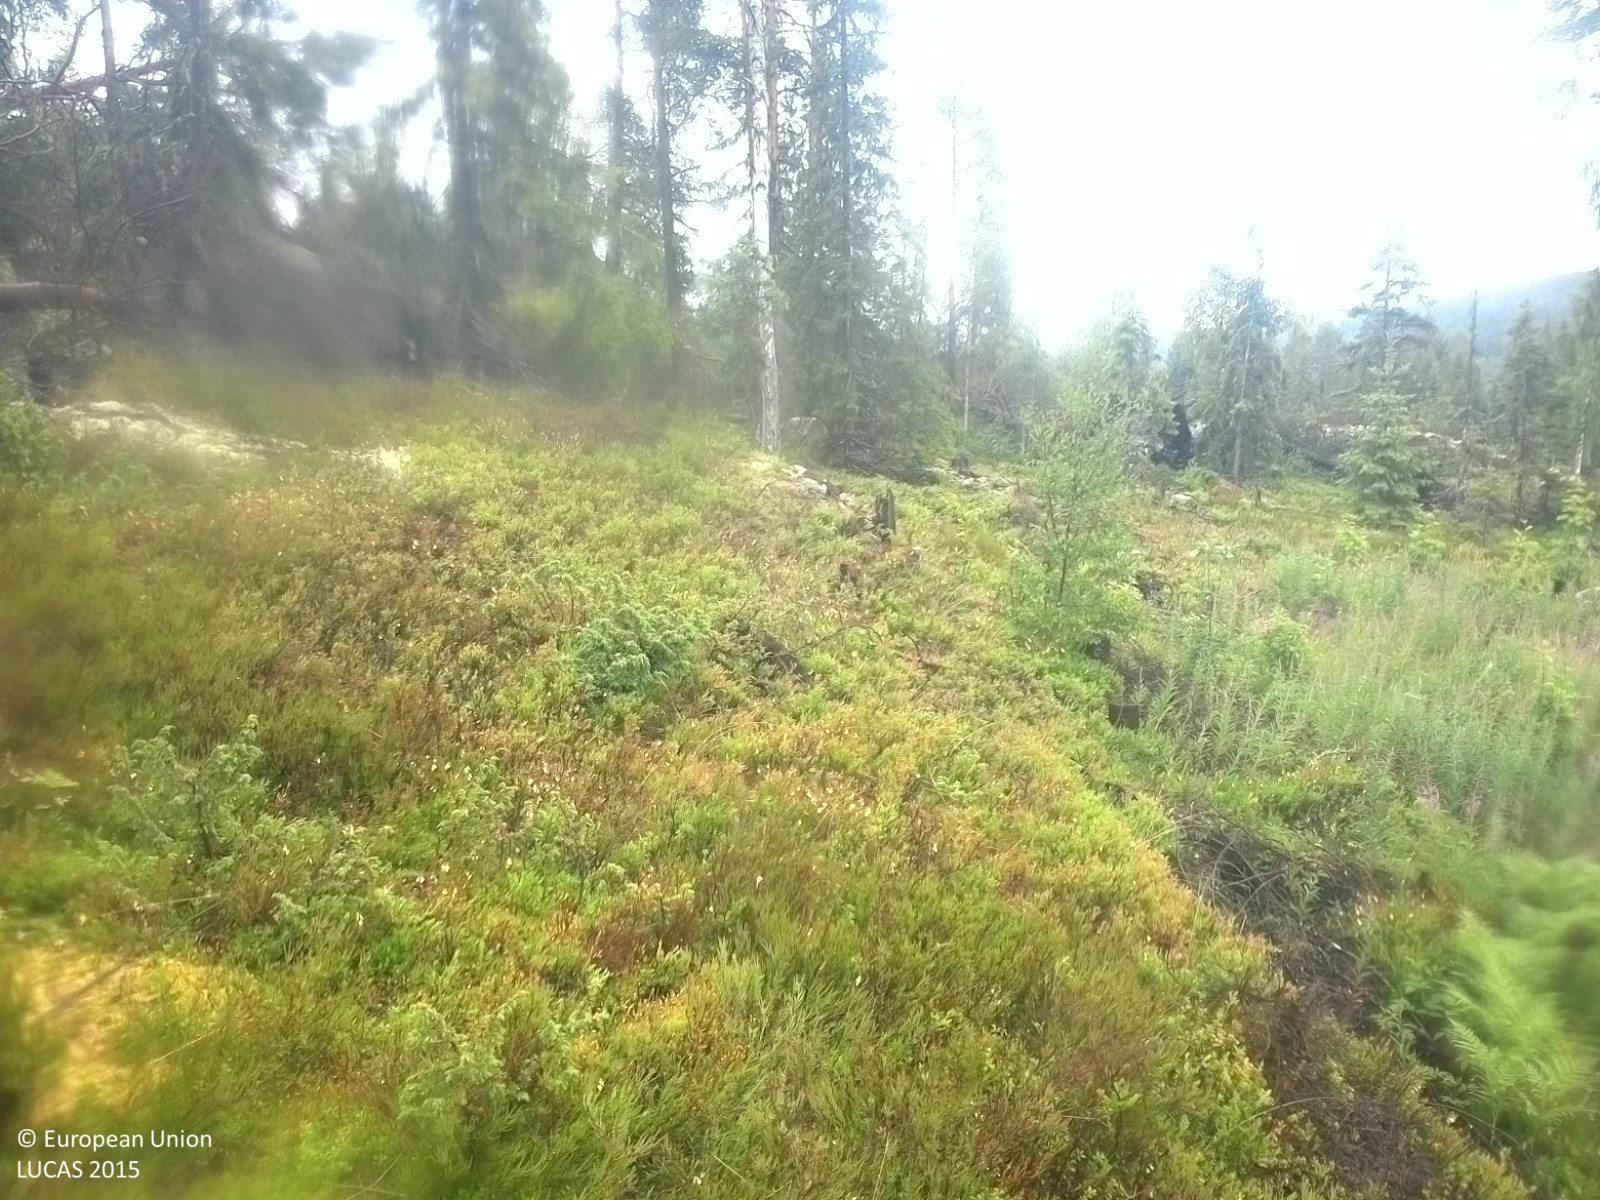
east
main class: Woodland
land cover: Other mixed woodland
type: boreal forest
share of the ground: 25 - 50 %
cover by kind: broadleaved forest trees 25 %, herbaceous plants 25 %, shrubs 20 %, lichens and mosses 20 %, coniferous forest trees 10 %
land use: Forestry
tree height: < 5 m
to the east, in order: Other mixed woodland; Pine dominated mixed woodland; Spruce dominated coniferous woodland
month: July
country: SE
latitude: 62.4112
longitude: 17.0446
